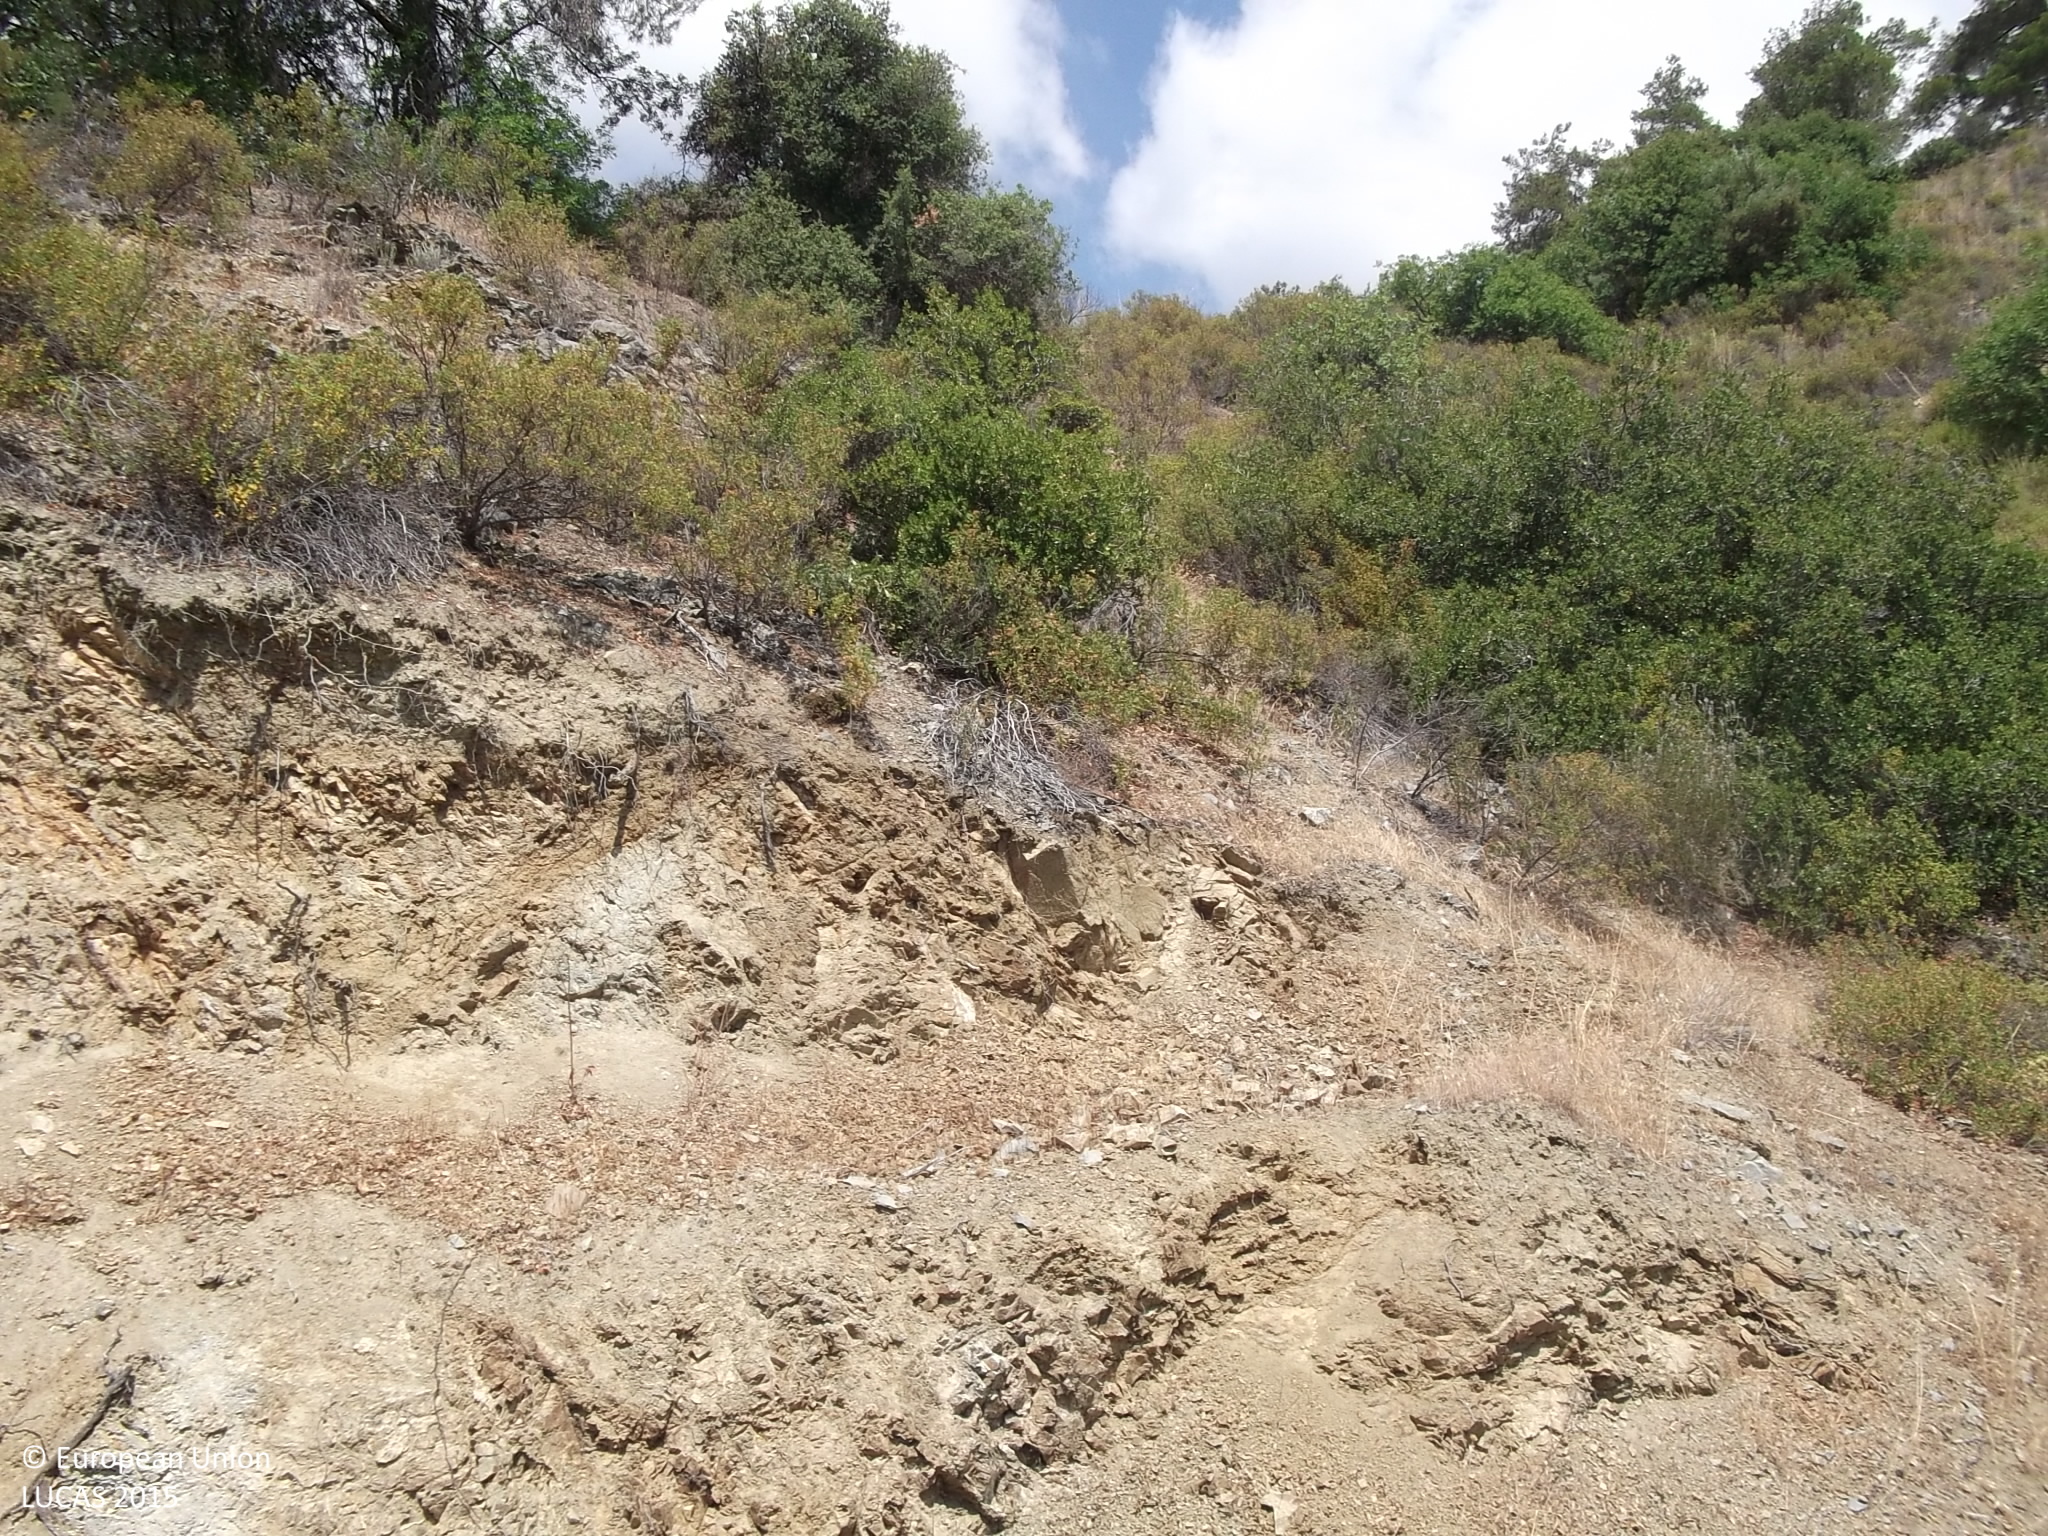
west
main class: Woodland
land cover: Pine dominated coniferous woodland
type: coniferous forest of the mediterranean region
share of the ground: > 75 %
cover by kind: coniferous forest trees 75 %, unconsolidated bare surface 15 %, shrubs 10 %
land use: Forestry
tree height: > 5 m
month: June
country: CY
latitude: 34.8624
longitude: 32.9523
